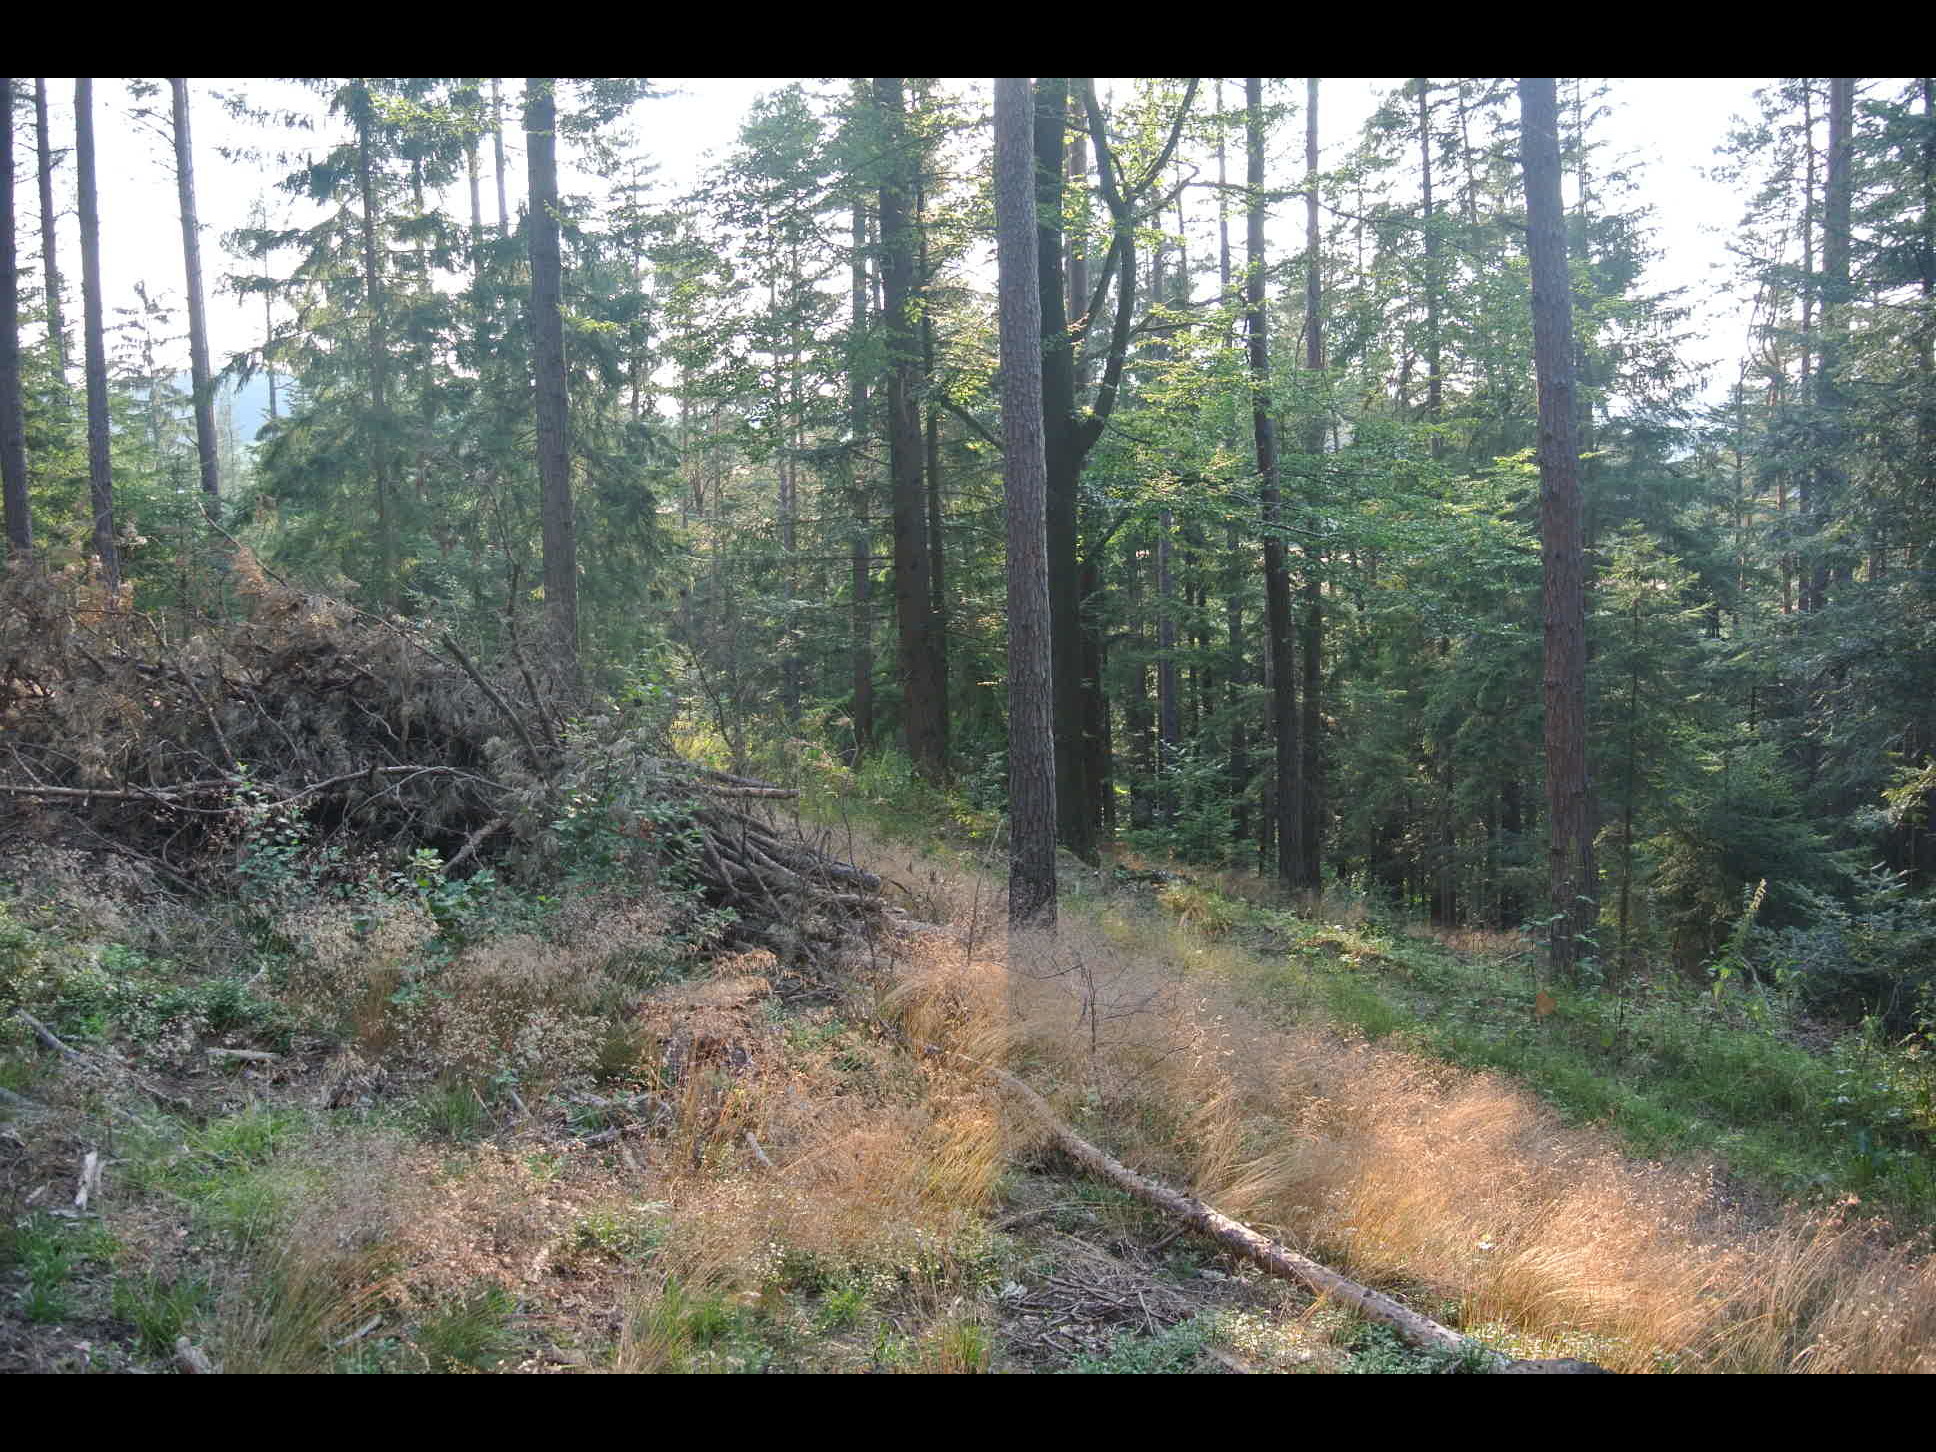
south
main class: Woodland
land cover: Other coniferous woodland
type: alpine coniferous forest
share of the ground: > 75 %
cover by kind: coniferous forest trees 100 %
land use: Forestry
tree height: > 5 m
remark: Clear cut
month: July
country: AT
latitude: 47.5119
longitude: 16.1238
